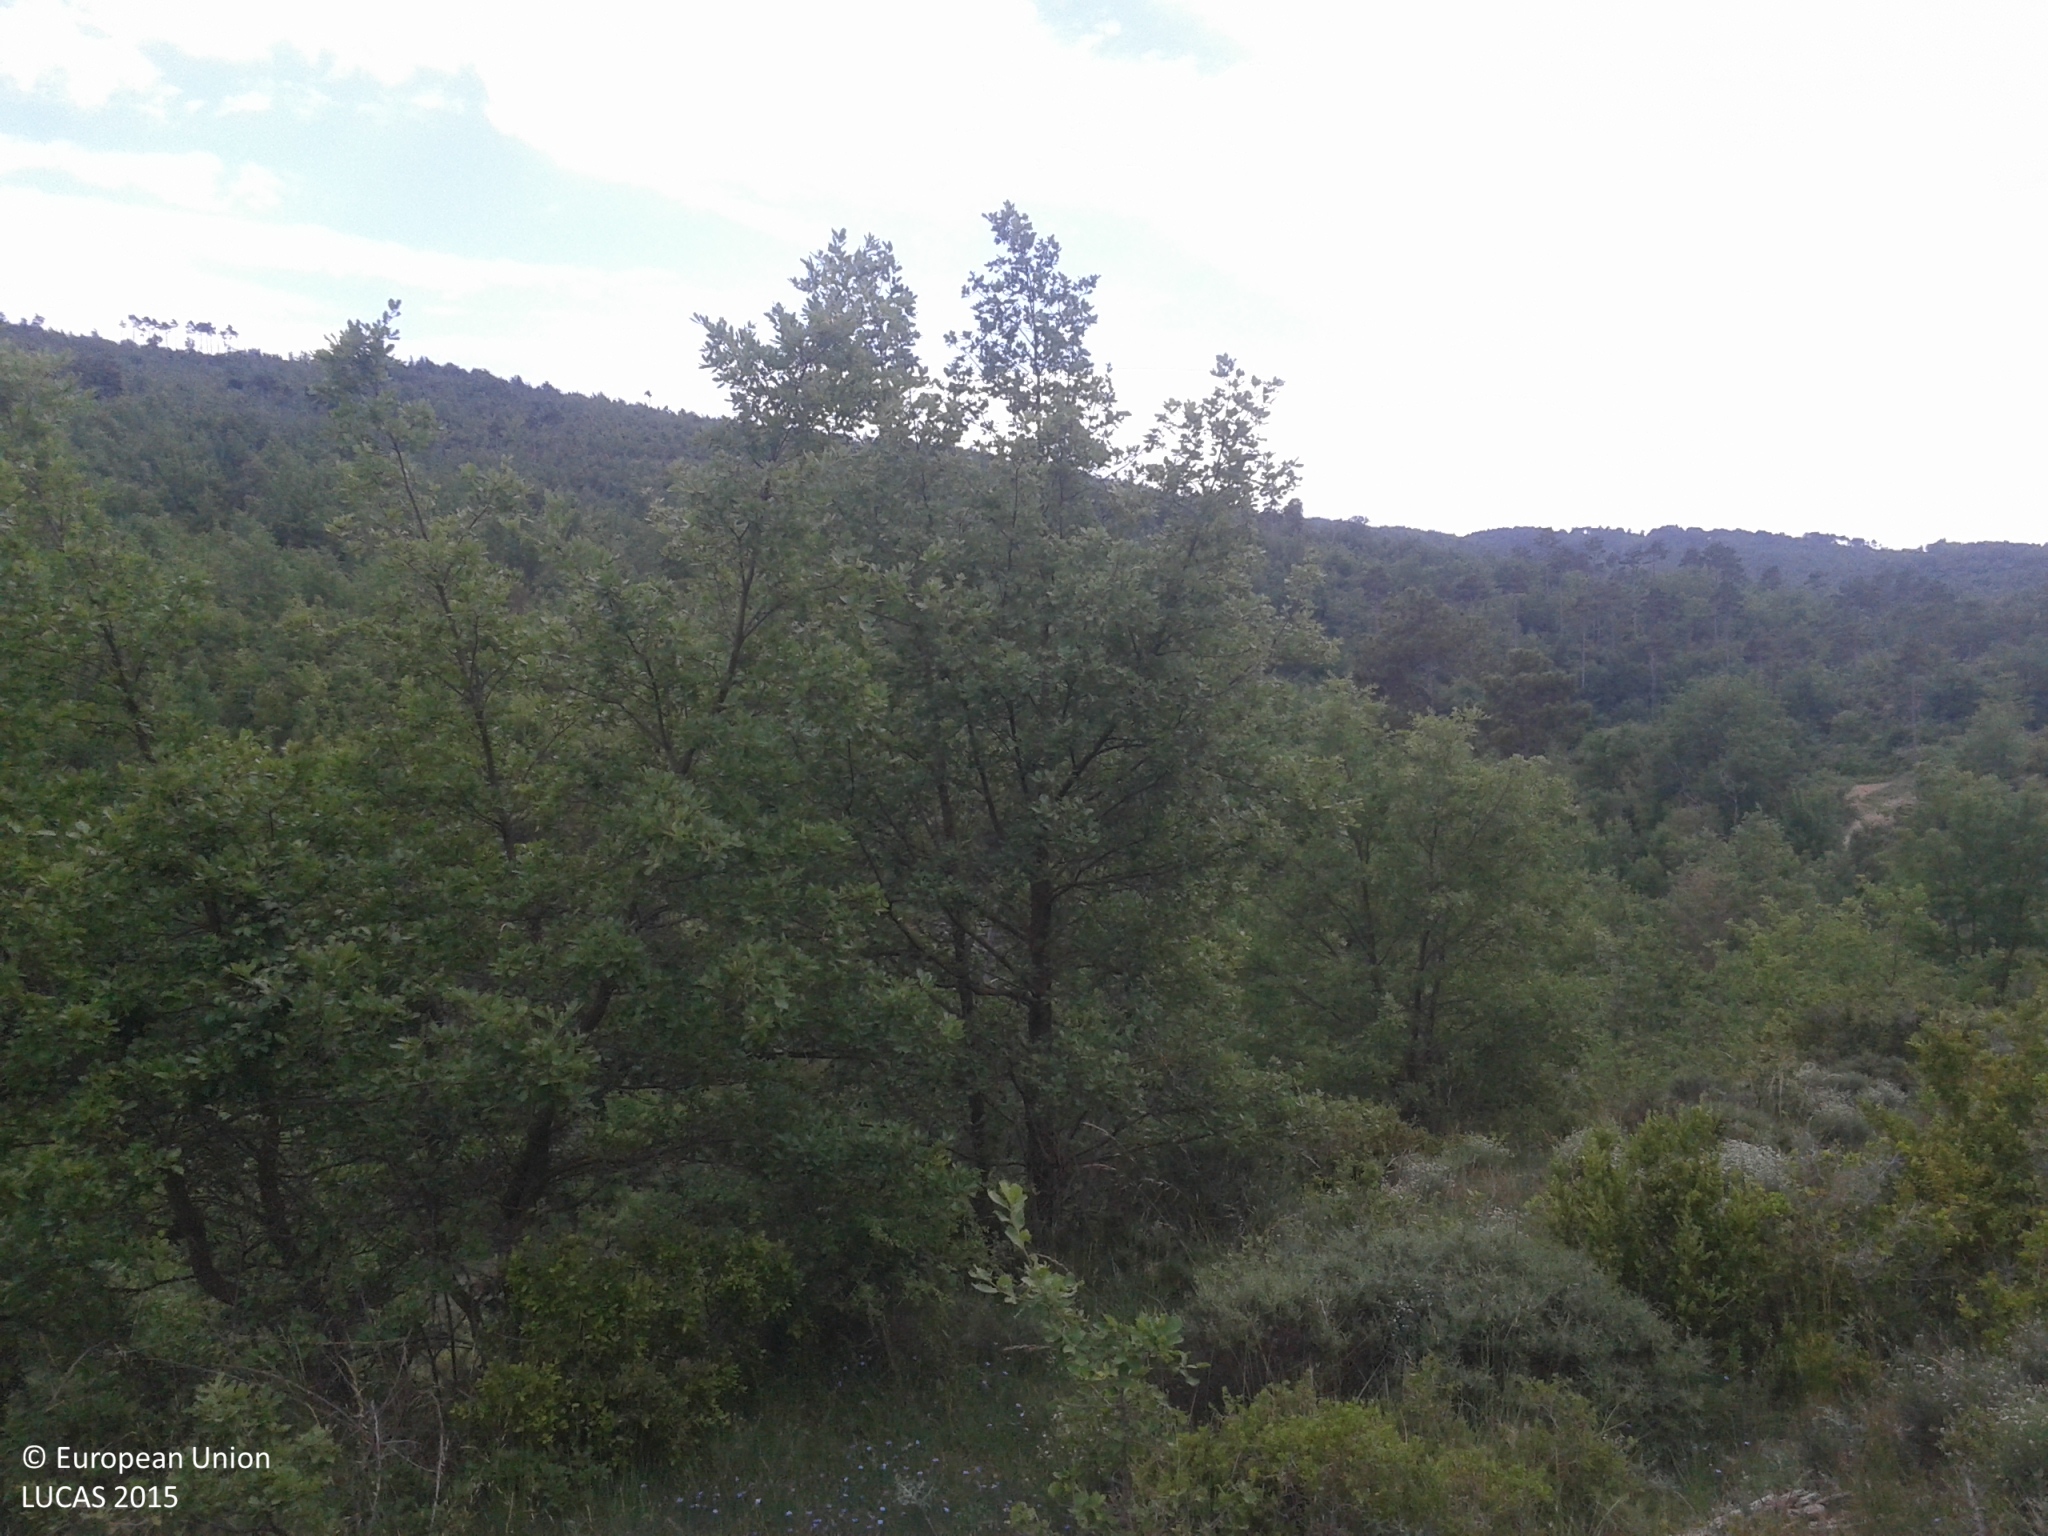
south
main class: Shrubland
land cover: Shrubland with sparse tree cover
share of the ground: > 75 %
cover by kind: shrubs 80 %, herbaceous plants 10 %, broadleaved forest trees 5 %, consolidated bare surface 5 %
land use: Agriculture (excluding fallow land and kitchen gardens)
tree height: < 5 m
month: May
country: ES
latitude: 41.8663
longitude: 1.5682
